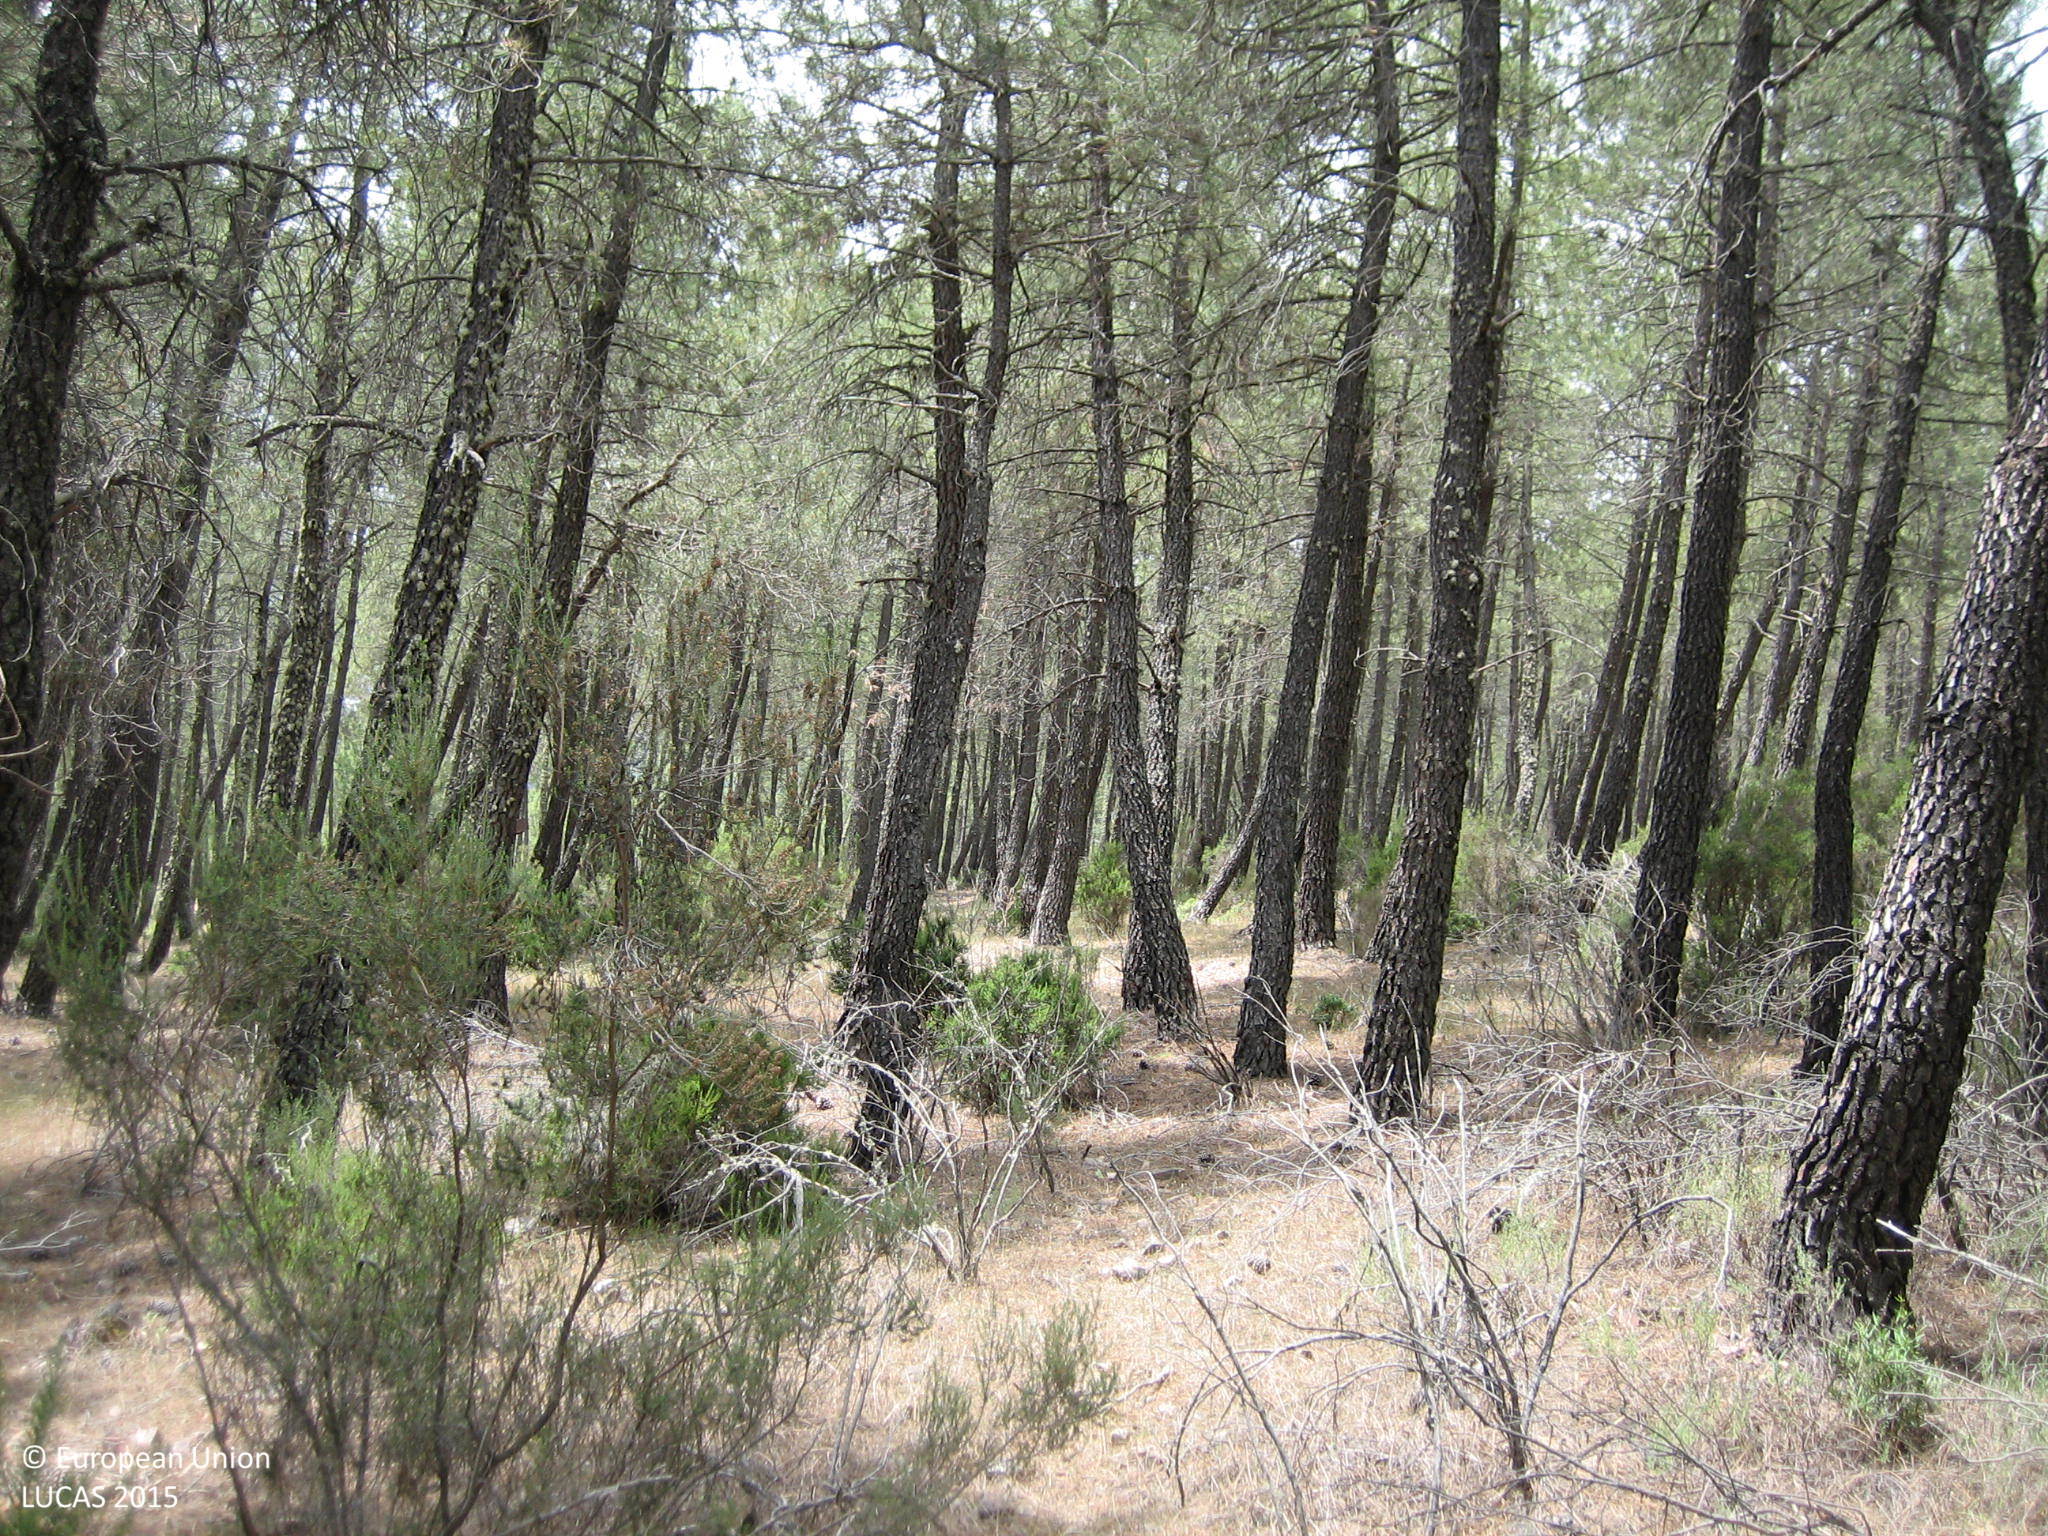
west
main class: Woodland
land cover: Pine dominated coniferous woodland
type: alpine coniferous forest
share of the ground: > 75 %
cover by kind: coniferous forest trees 85 %, herbaceous plants 10 %, shrubs 5 %
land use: Forestry
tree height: > 5 m
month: June
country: ES
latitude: 39.1107
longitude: -4.4974
